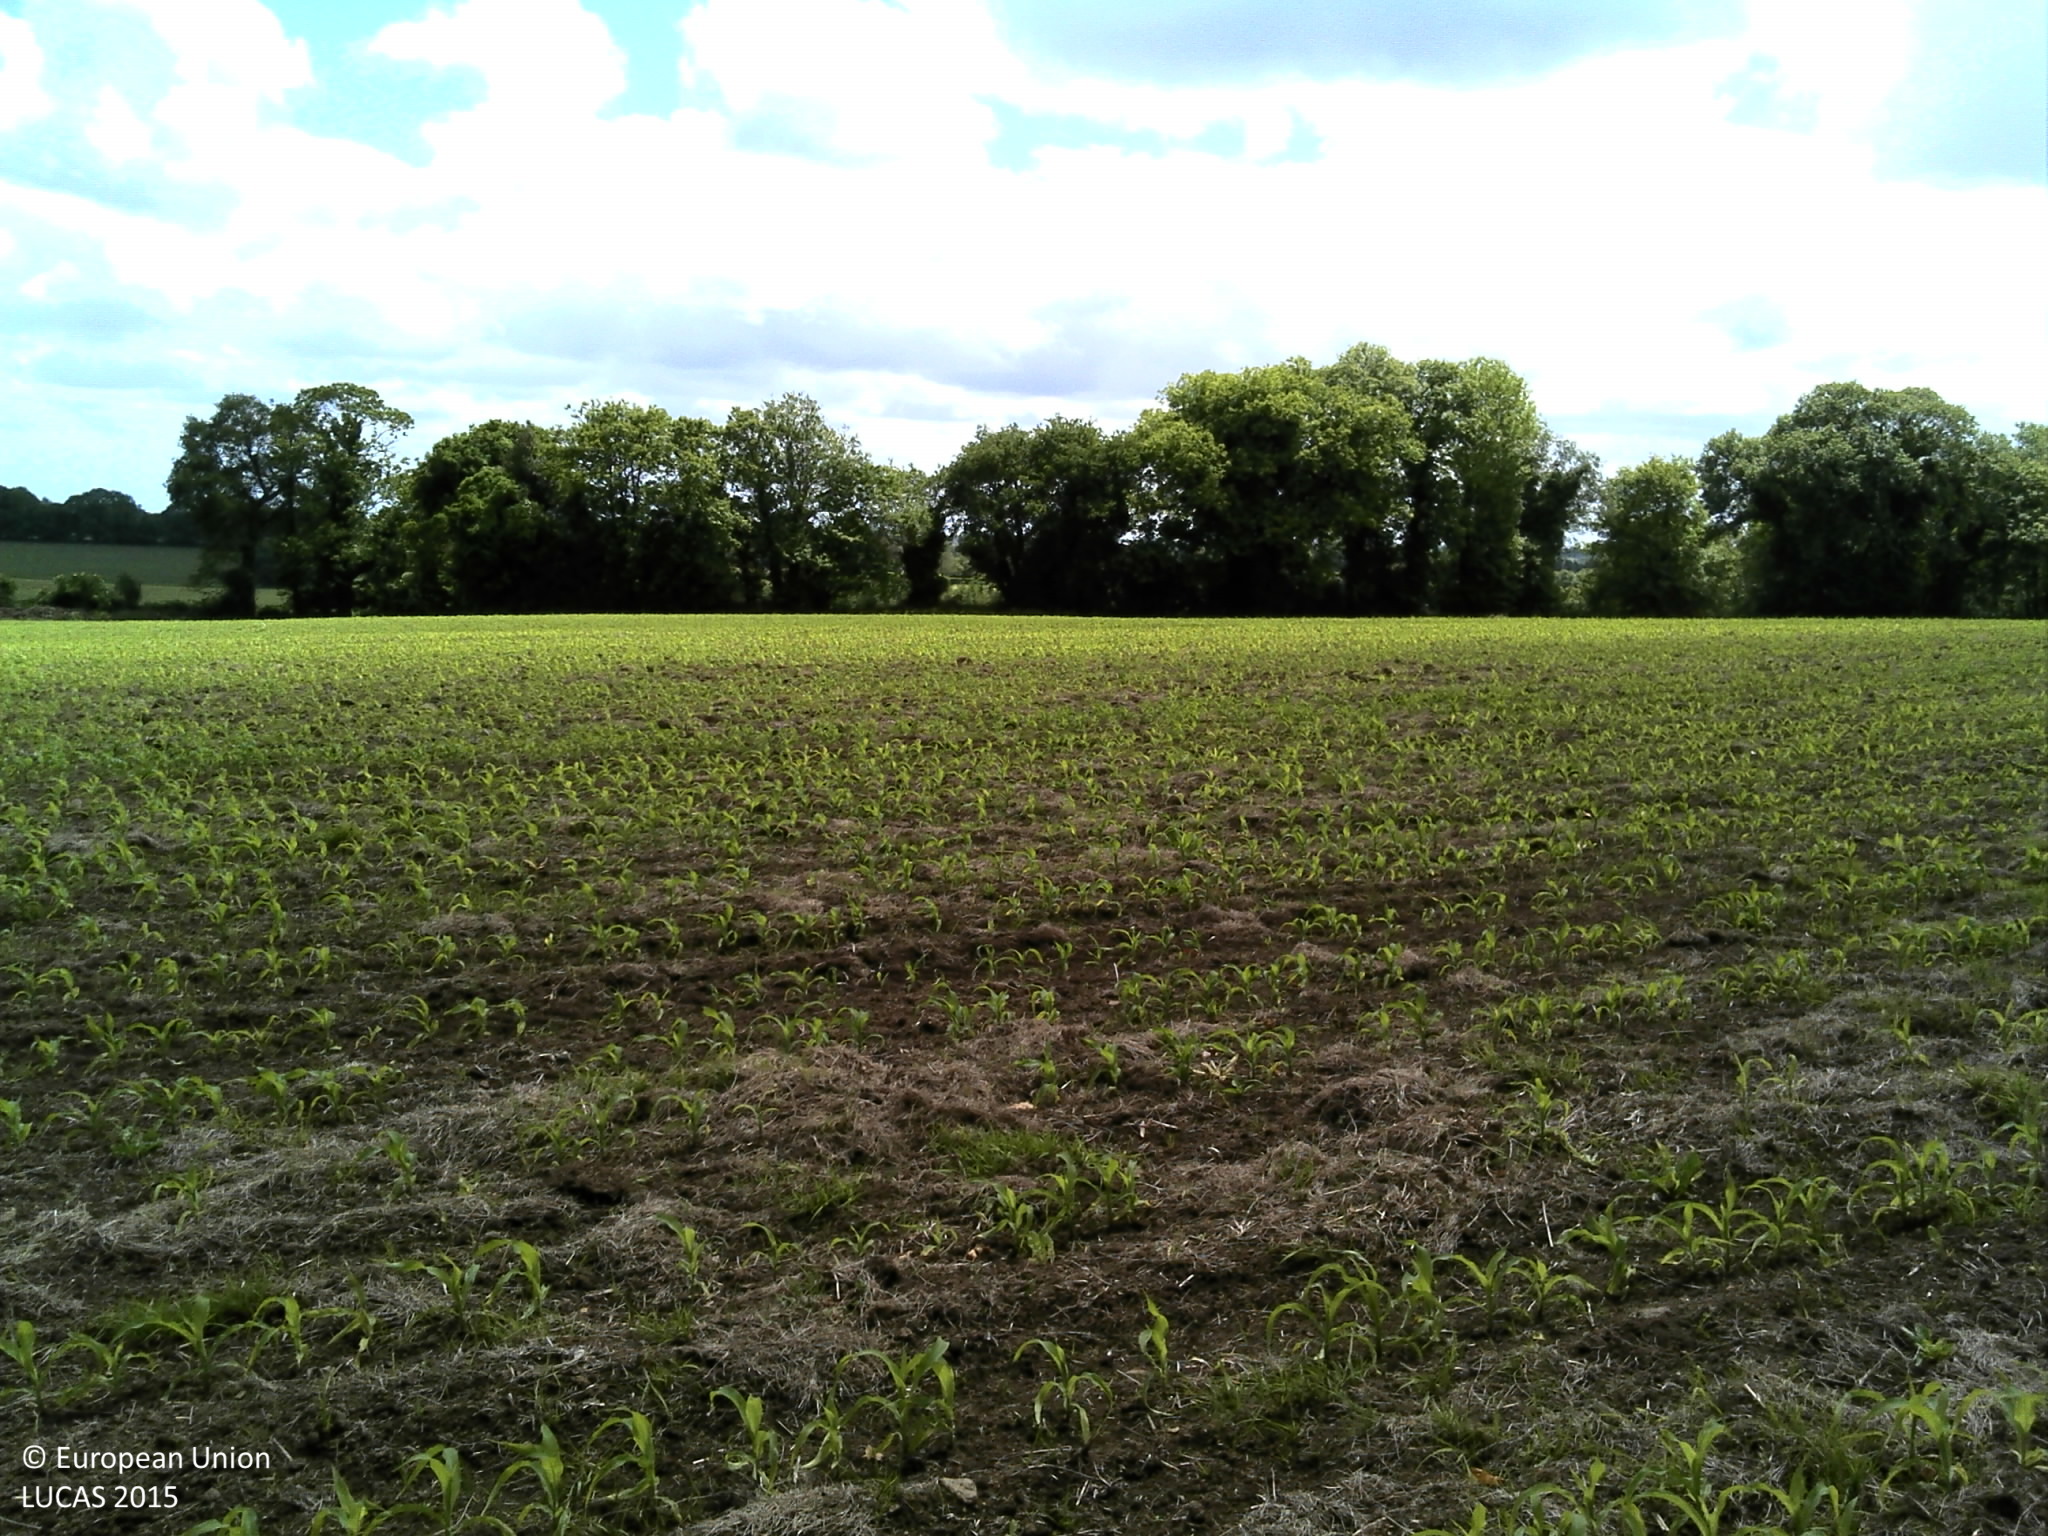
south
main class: Cropland
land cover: Maize
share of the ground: 10 - 25 %
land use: Agriculture (excluding fallow land and kitchen gardens)
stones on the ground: 10 - 25 %
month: June
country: FR
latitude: 47.9608
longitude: -3.5911
